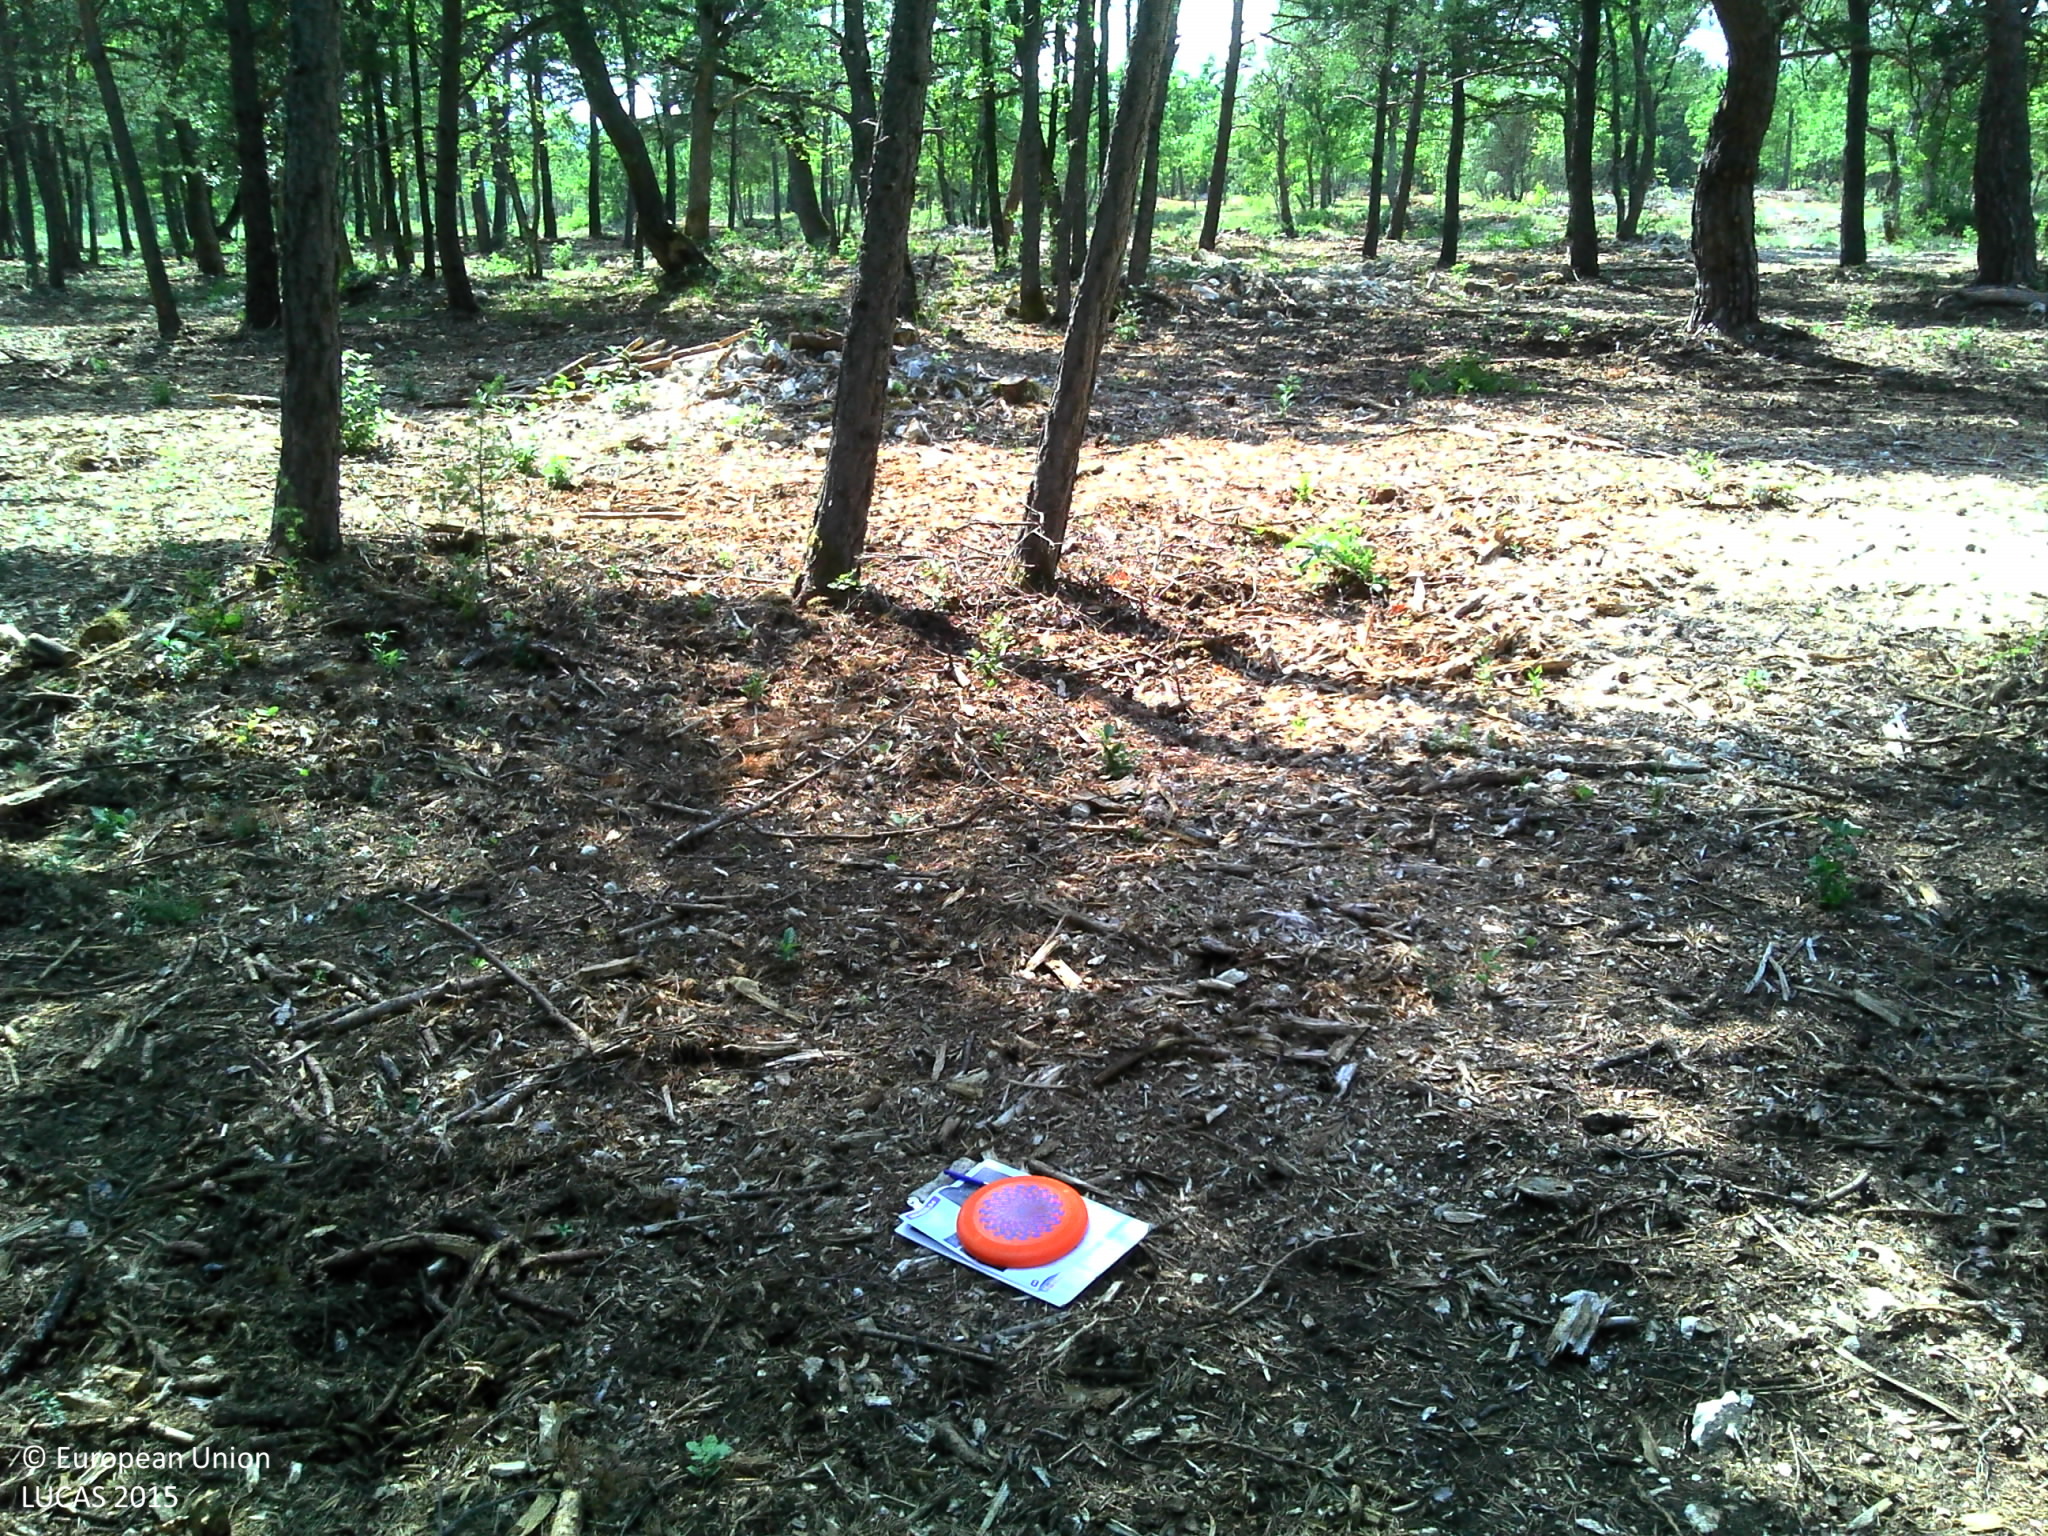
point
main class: Woodland
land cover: Pine dominated mixed woodland
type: mesophytic deciduous forest
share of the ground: > 75 %
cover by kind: coniferous forest trees 35 %, broadleaved forest trees 20 %, shrubs 20 %, unconsolidated bare surface 20 %, herbaceous plants 5 %
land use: Forestry
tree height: > 5 m
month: July
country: FR
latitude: 44.0118
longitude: 5.3558
